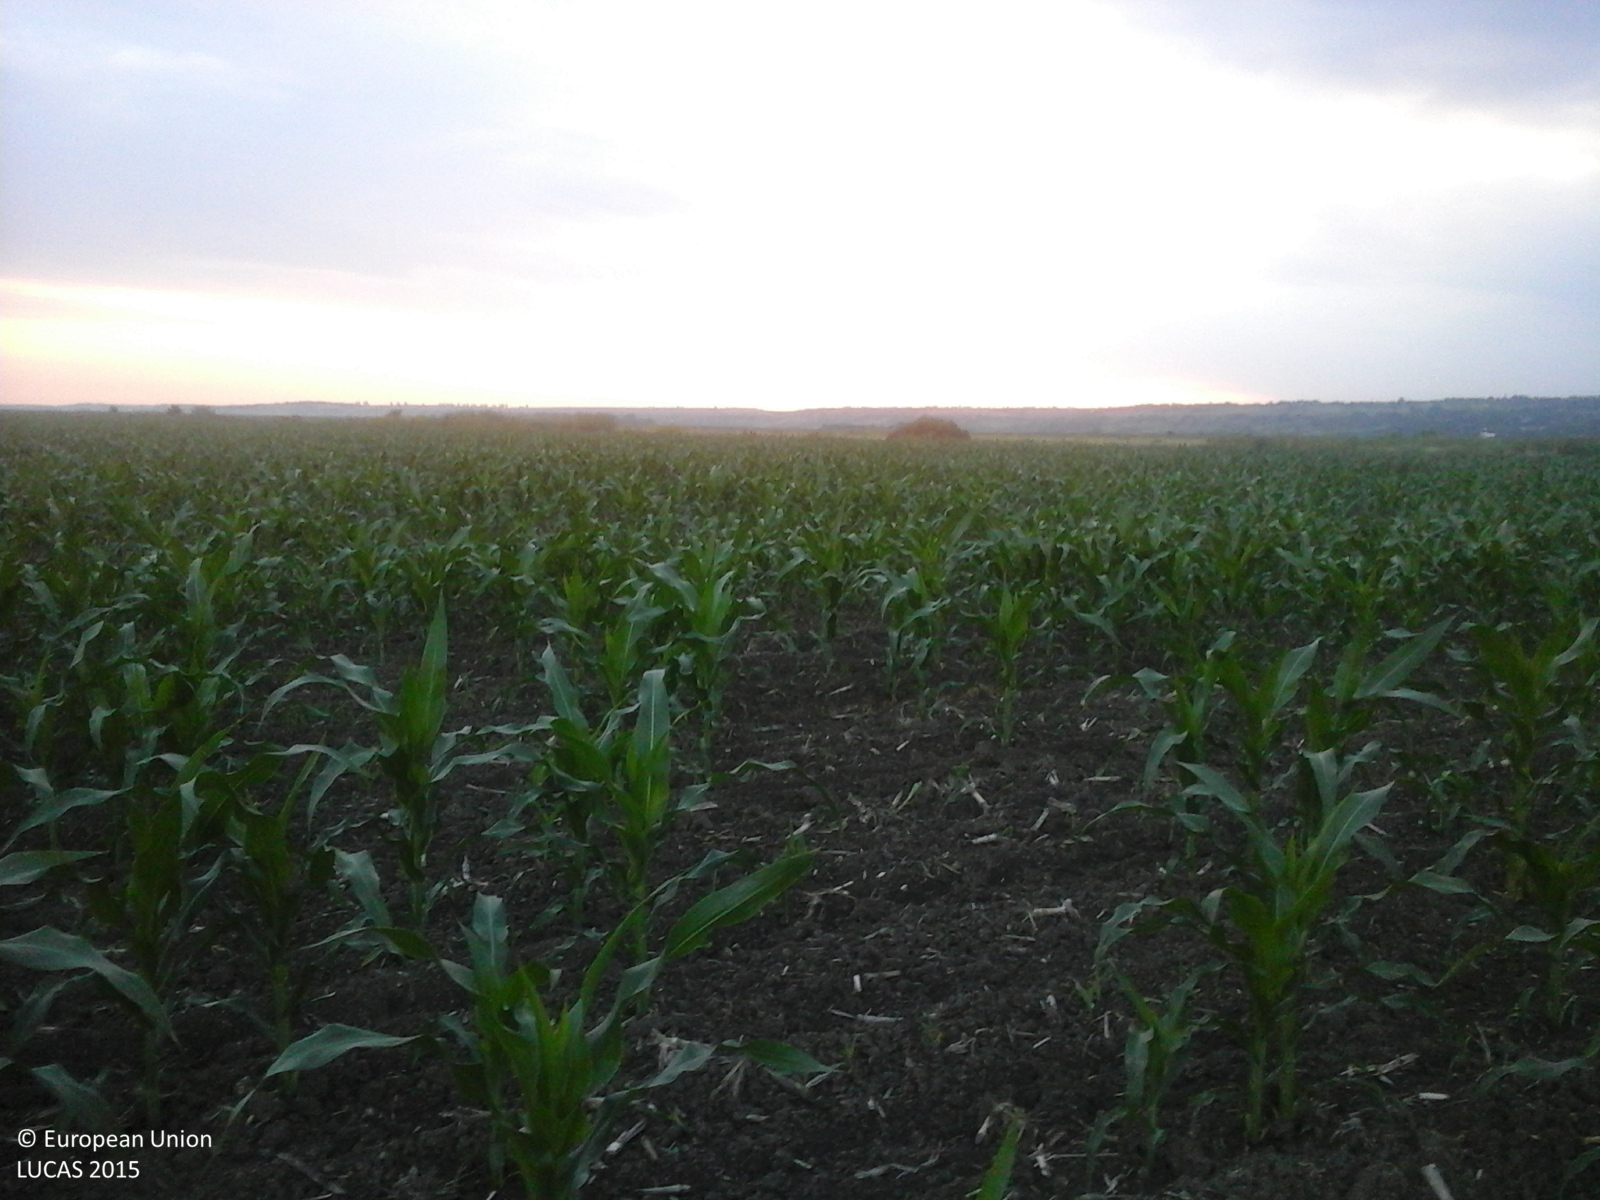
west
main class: Cropland
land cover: Maize
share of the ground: 25 - 50 %
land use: Agriculture (excluding fallow land and kitchen gardens)
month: June
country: RO
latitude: 44.0365
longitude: 26.1111
